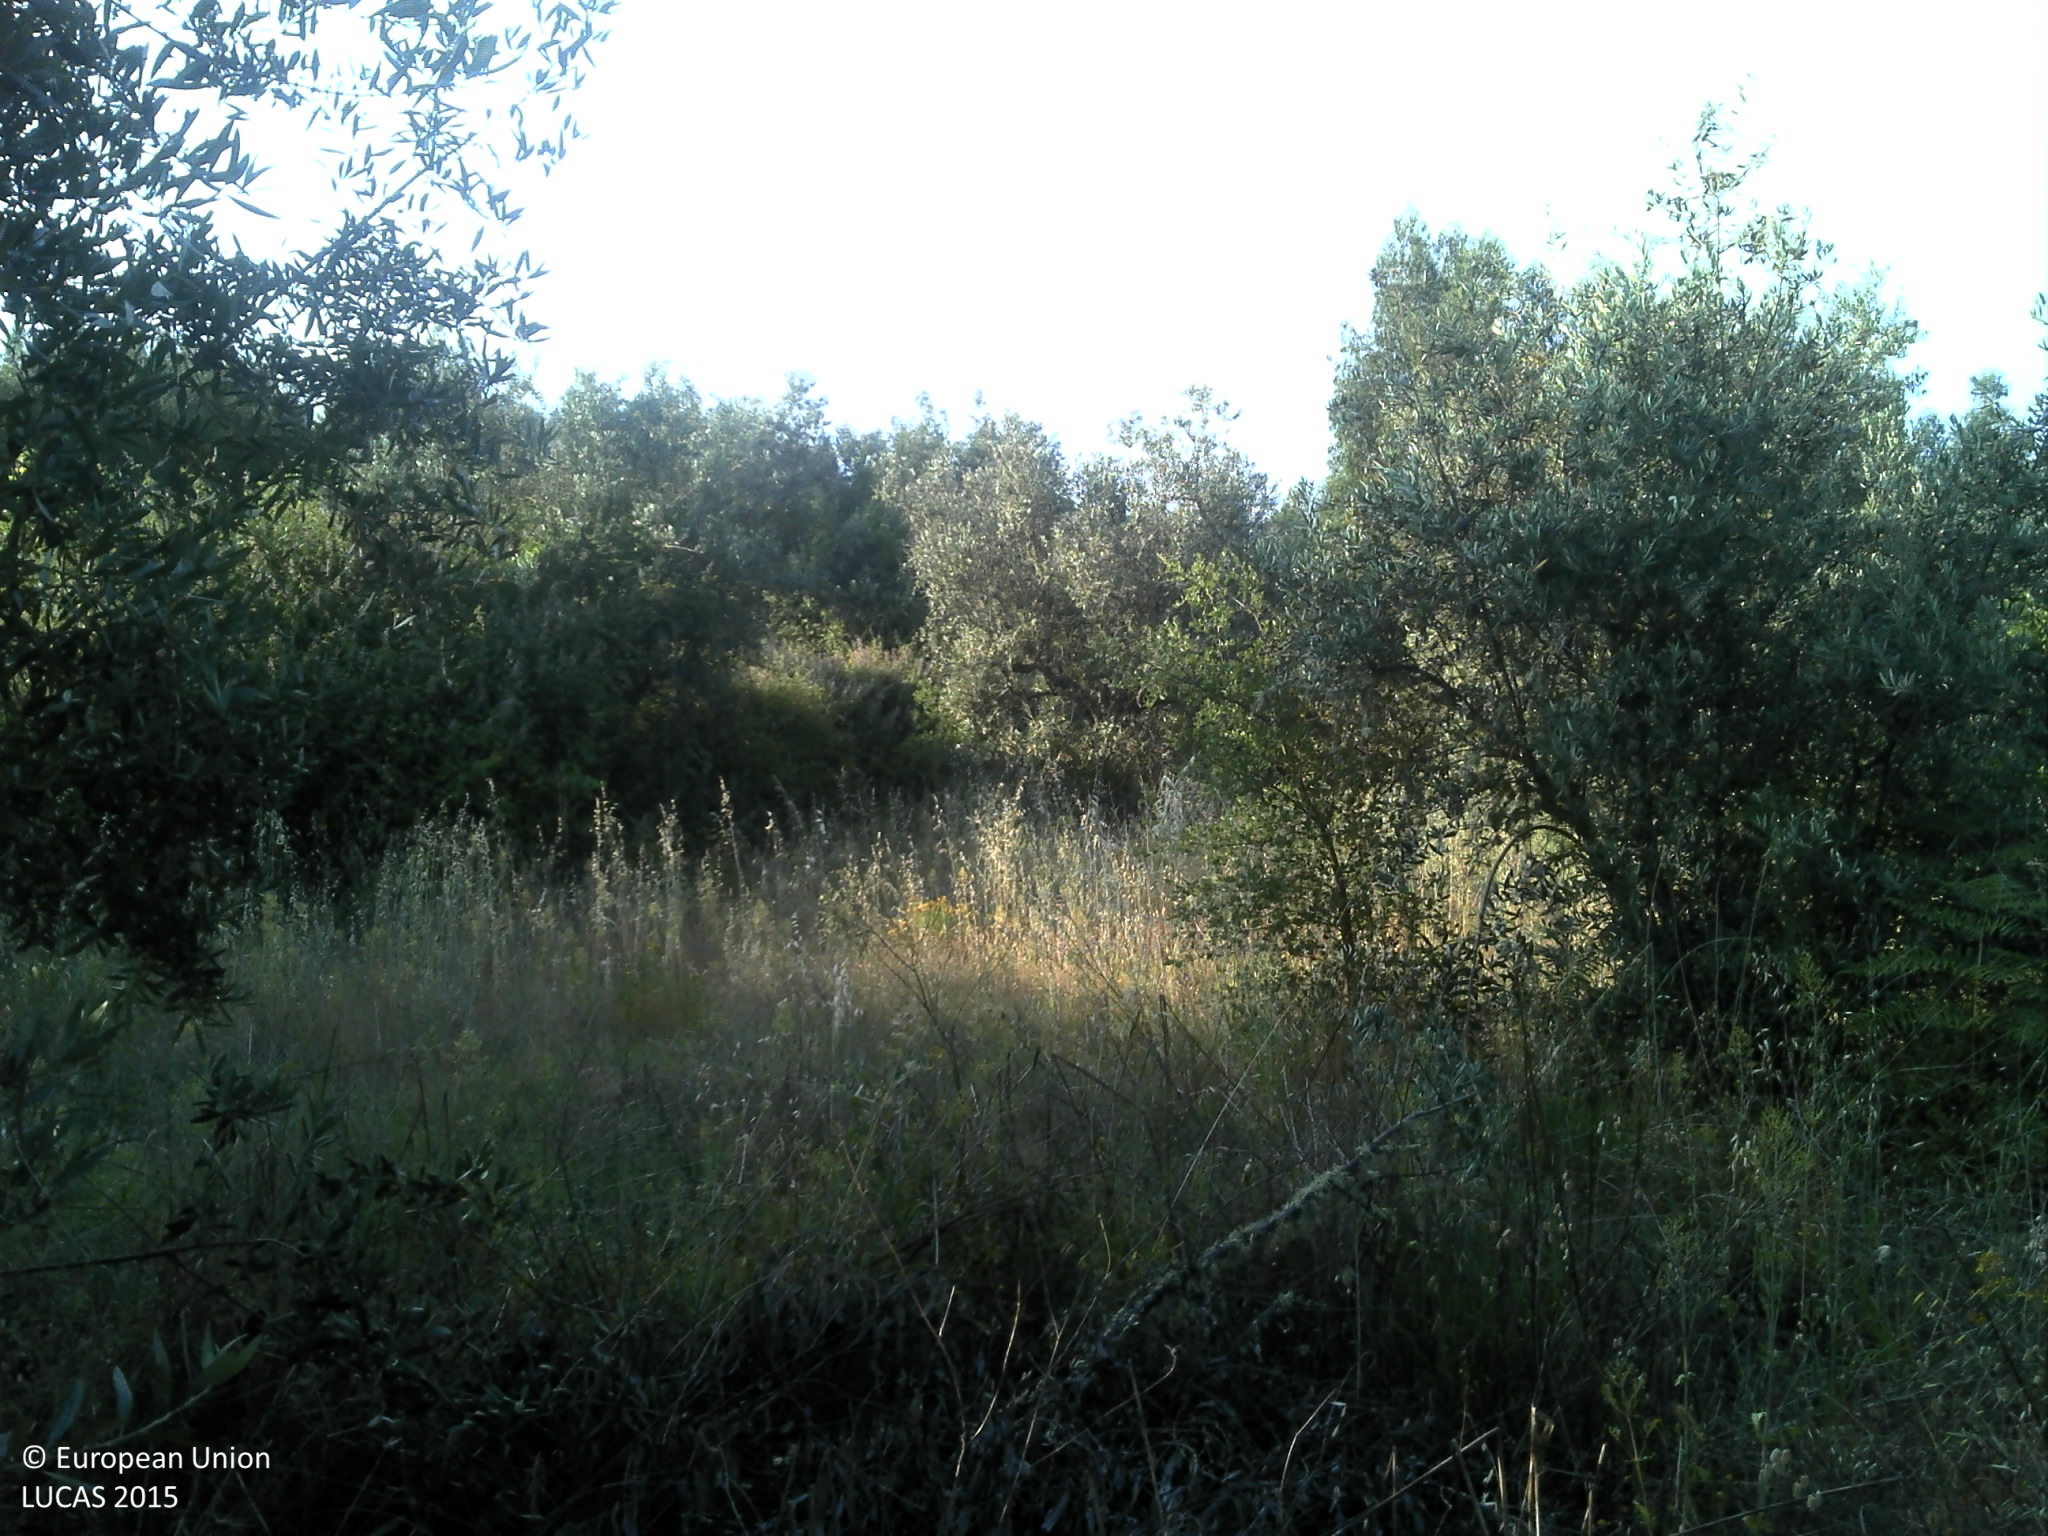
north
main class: Cropland
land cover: Olive groves
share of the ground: 25 - 50 %
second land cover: Shrubland without tree cover
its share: 50 - 75 %
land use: Agriculture (excluding fallow land and kitchen gardens)
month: June
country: PT
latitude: 39.3654
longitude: -7.9887
